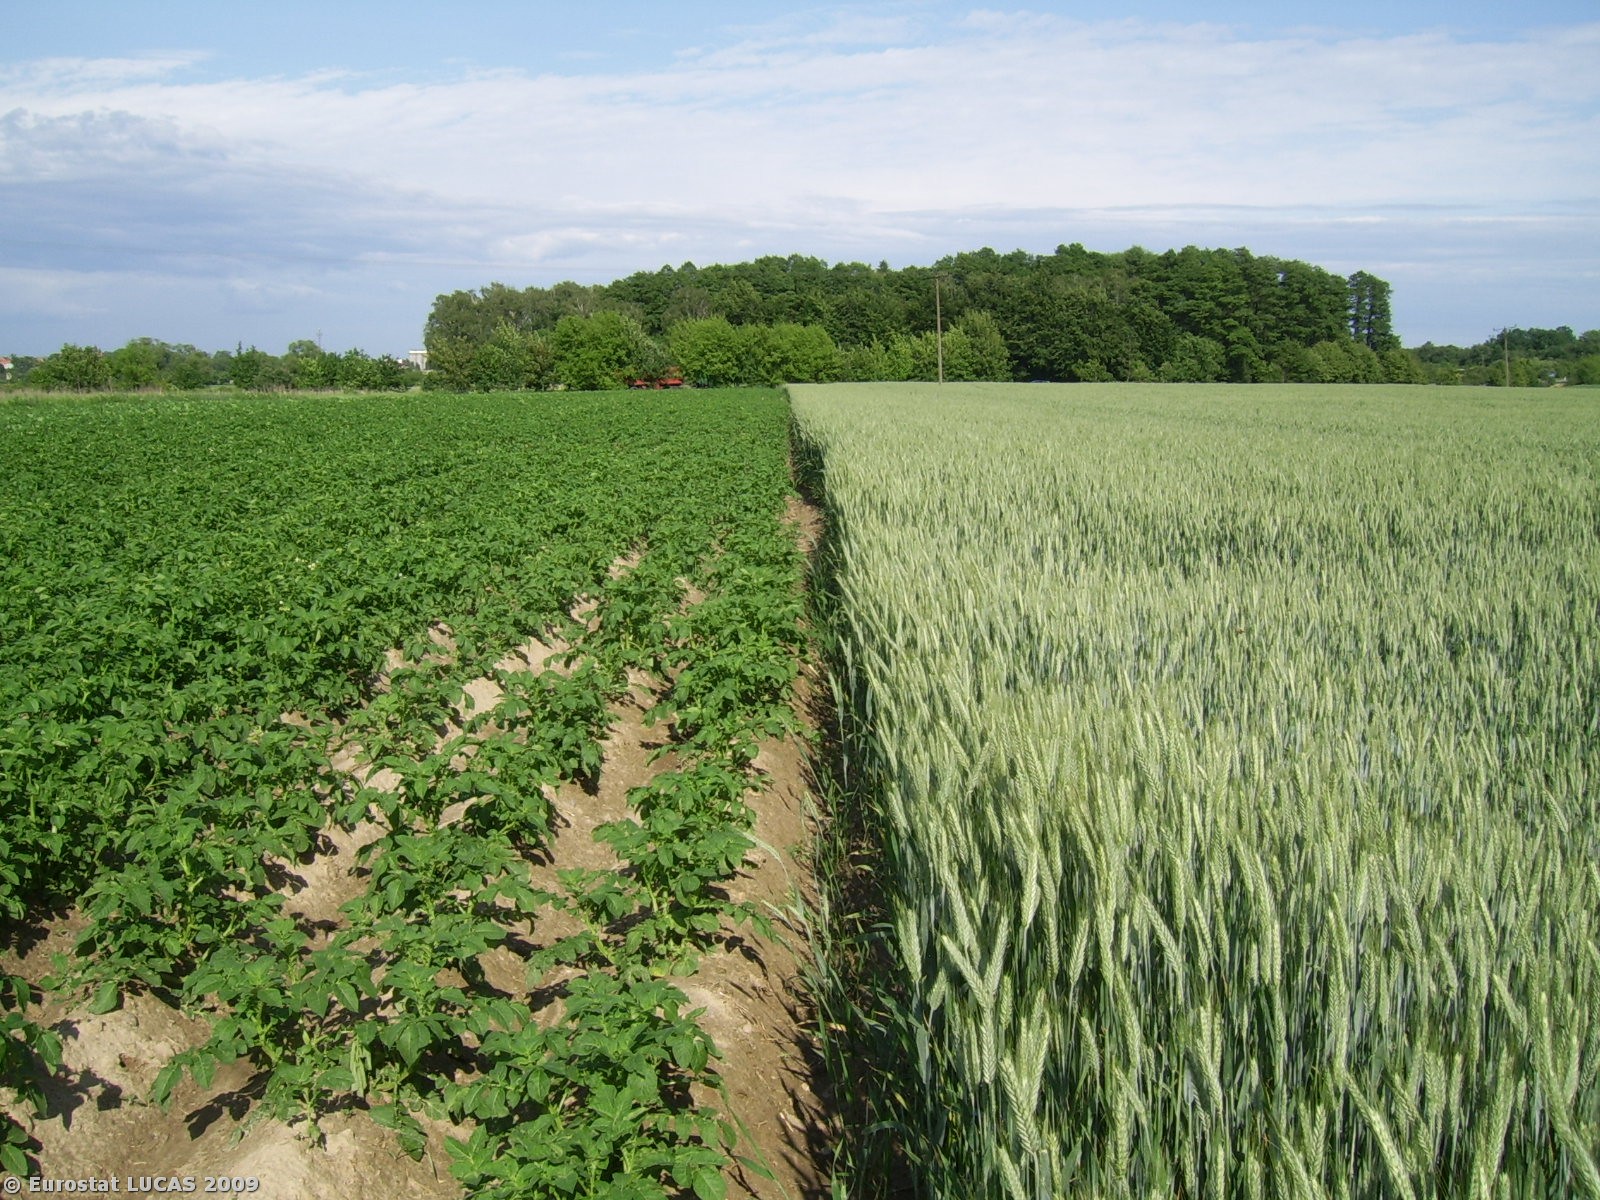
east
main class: Cropland
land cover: Triticale
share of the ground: > 75 %
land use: Agriculture (excluding fallow land and kitchen gardens)
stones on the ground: < 10 %
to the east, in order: Triticale; Grass margins; Lines of trees; Grass margins; Ditches and canals; Grass margins; Paved roads, cycling and walking lanes; Grass margins; Rivers and streams; Grassland with sparse tree/shrub cover; Triticale
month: June
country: PL
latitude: 51.8886
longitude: 17.7586
